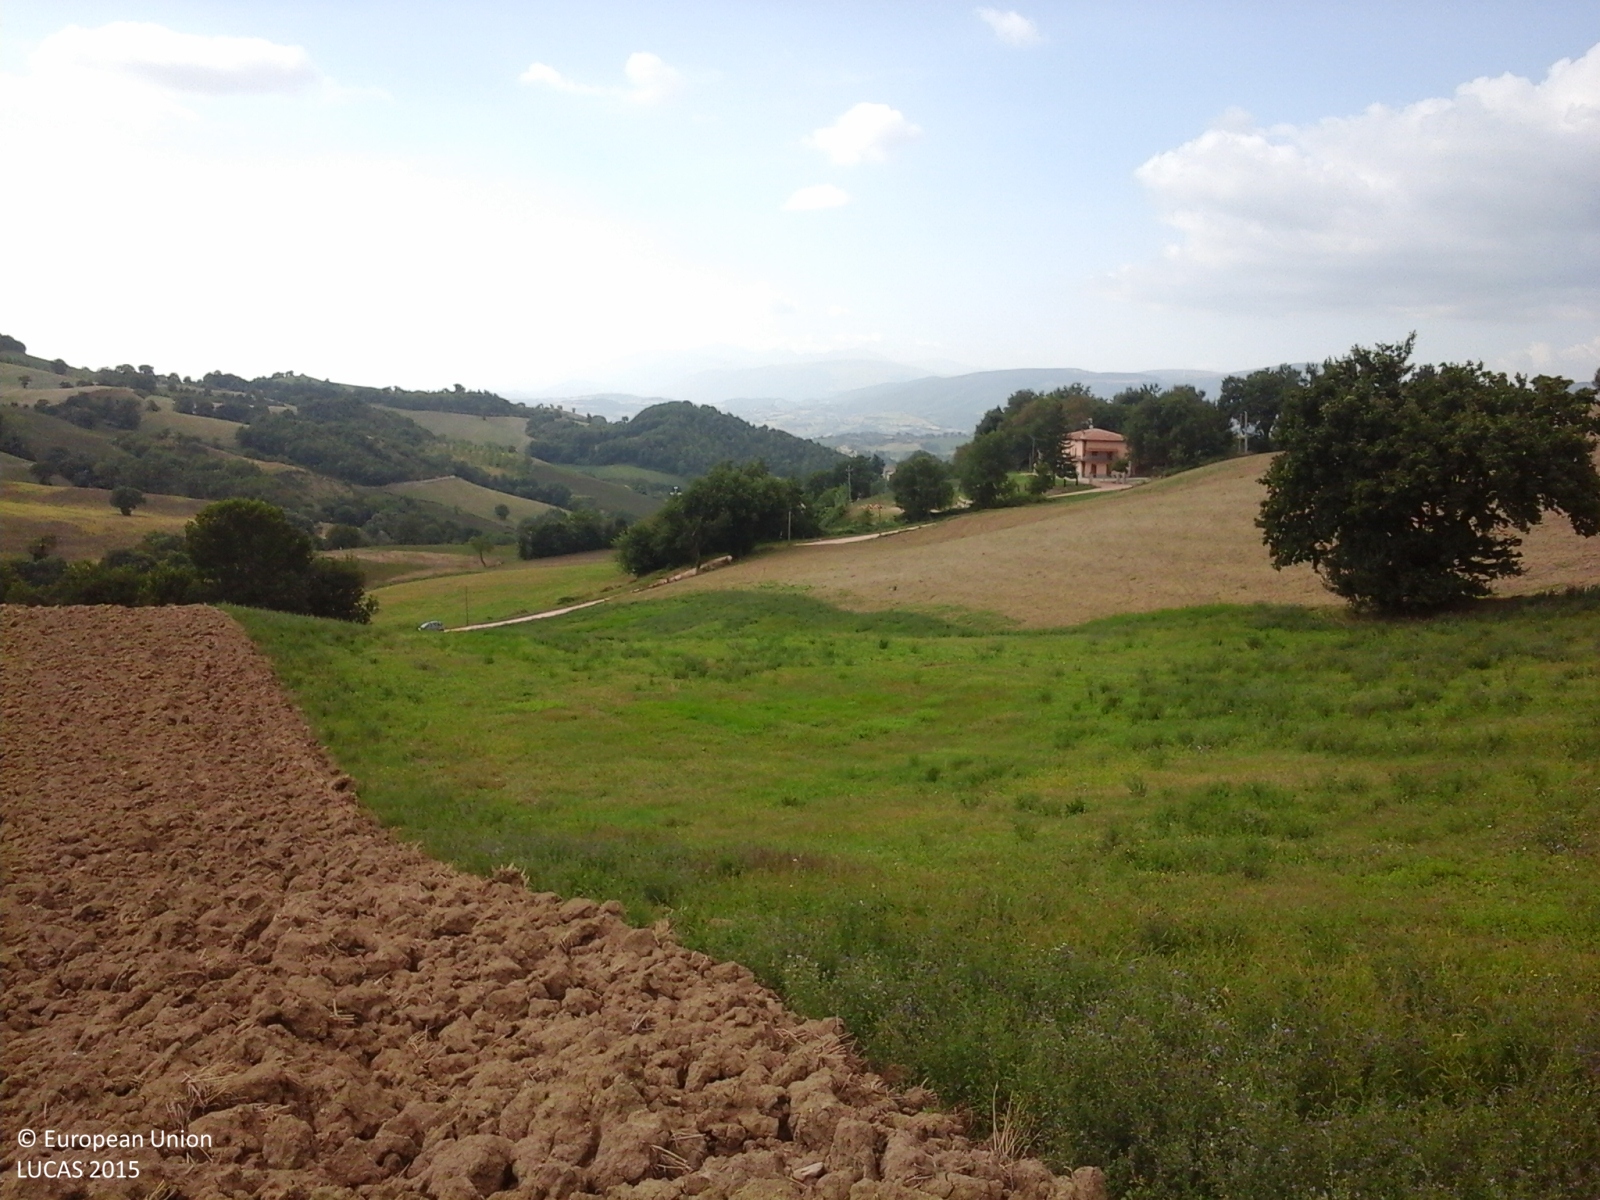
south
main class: Cropland
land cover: Durum wheat
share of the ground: < 10 %
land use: Agriculture (excluding fallow land and kitchen gardens)
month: August
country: IT
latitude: 43.3086
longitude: 13.1848
